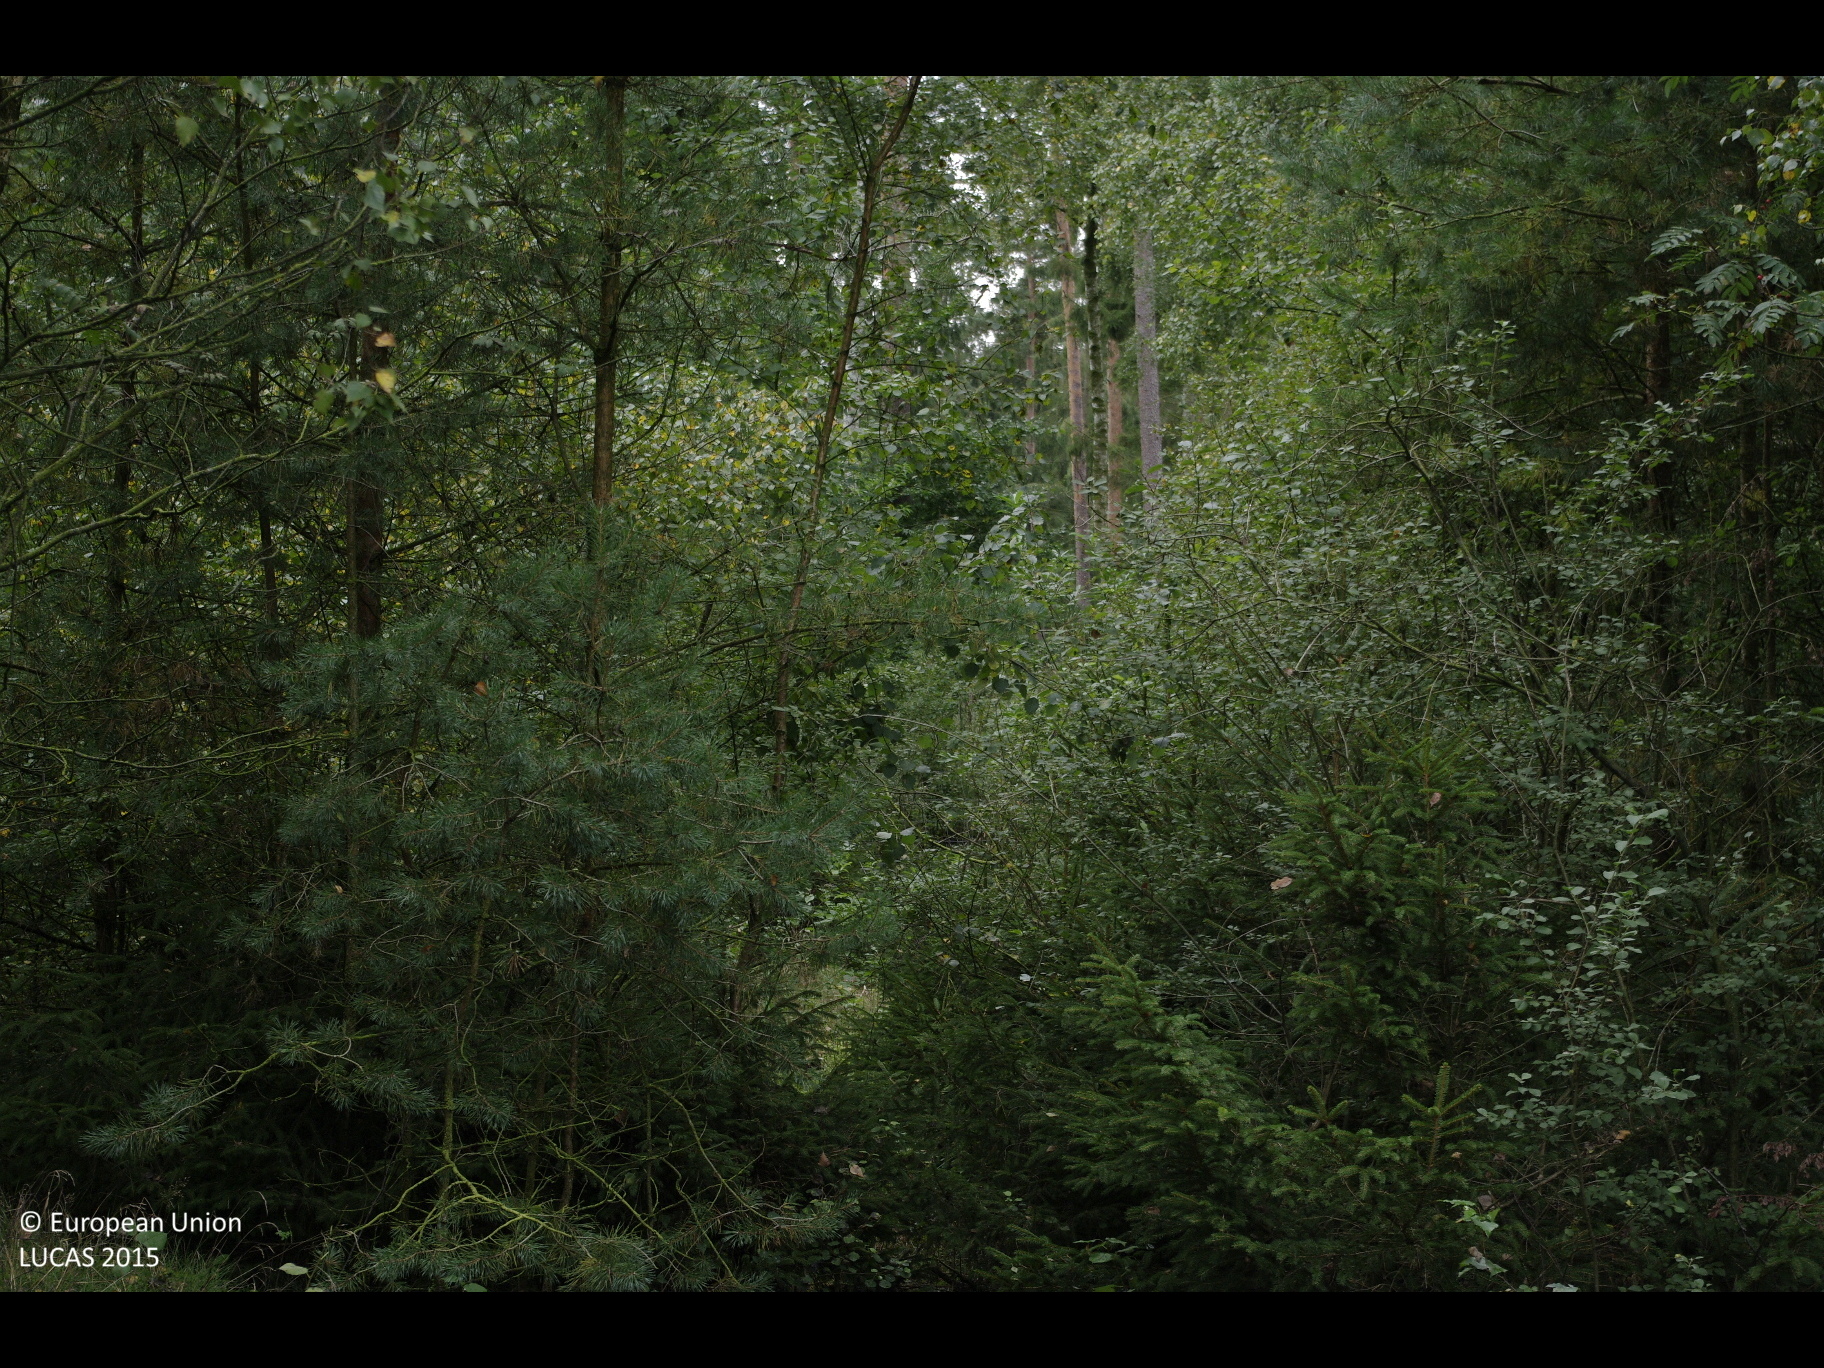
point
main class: Woodland
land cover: Pine dominated mixed woodland
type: hemiboreal forest and nemoral coniferous forest and mixed broadleaved-coniferous forest
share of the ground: > 75 %
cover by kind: coniferous forest trees 50 %, broadleaved forest trees 30 %, herbaceous plants 20 %
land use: Forestry
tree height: > 5 m
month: September
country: DE
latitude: 53.0964
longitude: 9.9254
